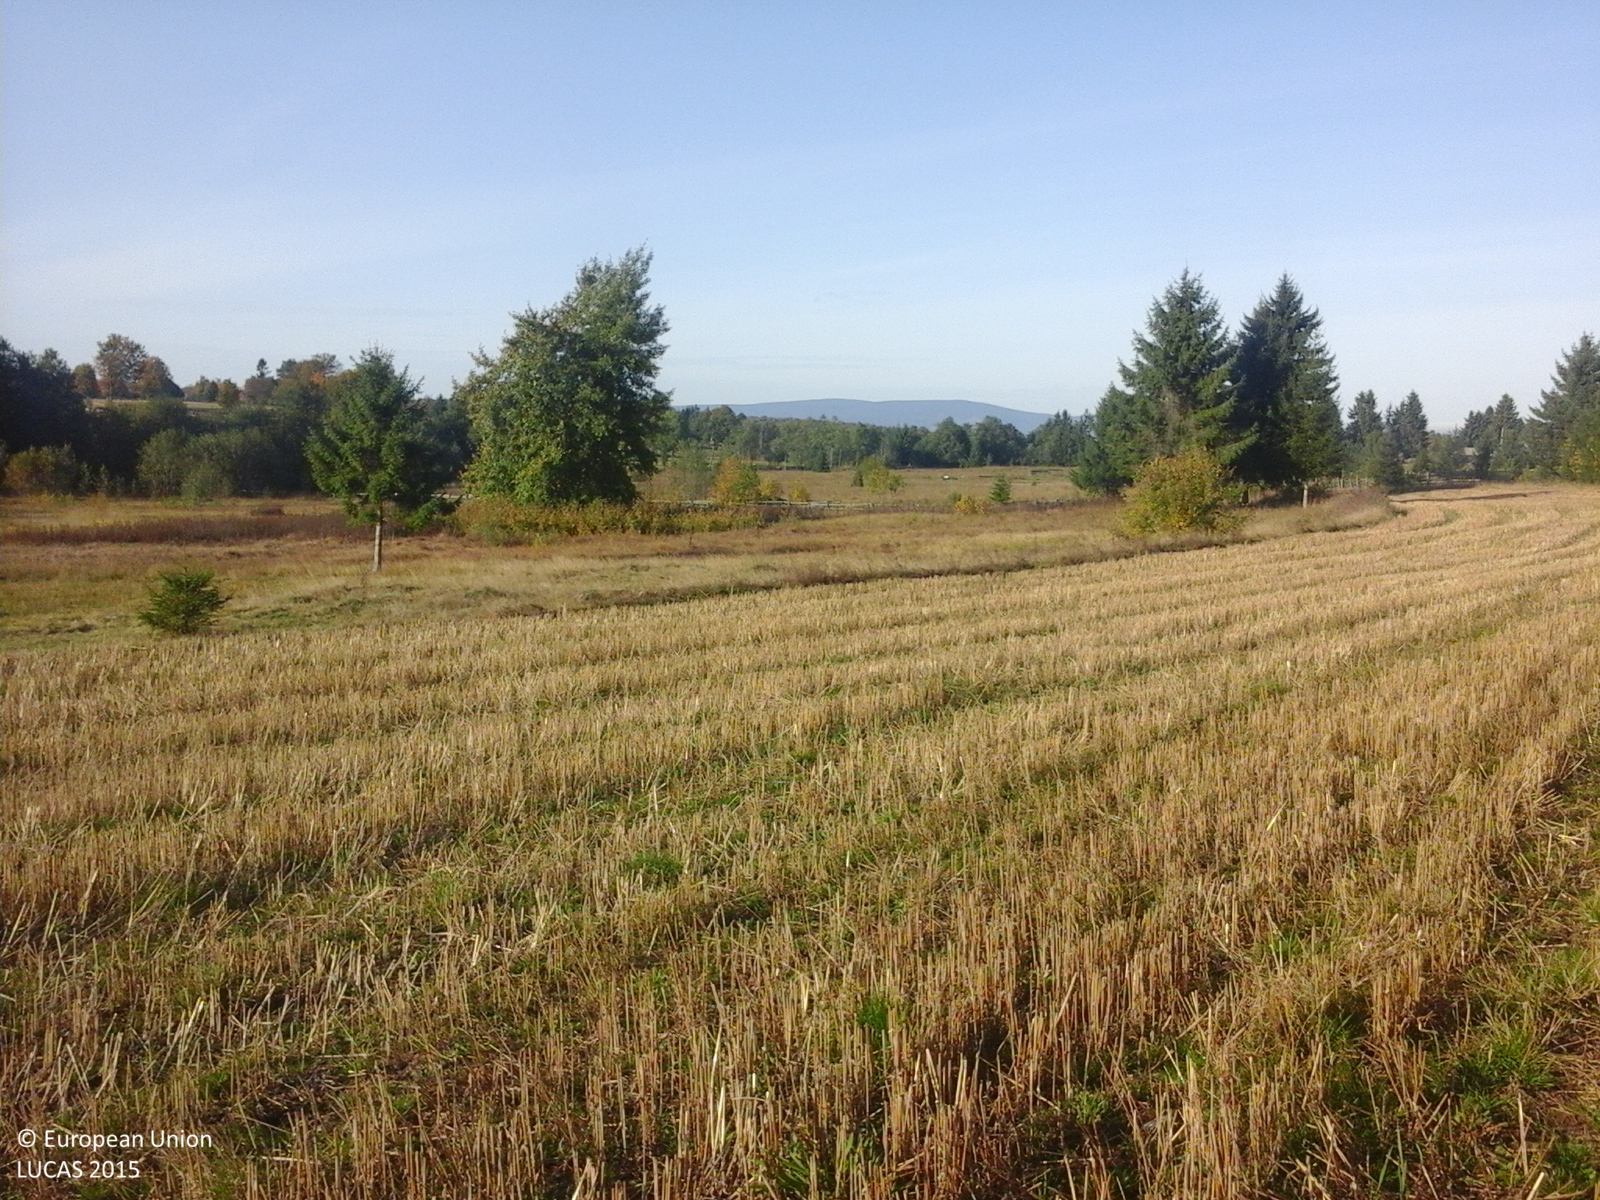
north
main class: Cropland
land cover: Barley
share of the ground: > 75 %
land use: Agriculture (excluding fallow land and kitchen gardens)
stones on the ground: < 10 %
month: October
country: RO
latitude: 46.5156
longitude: 25.2353
